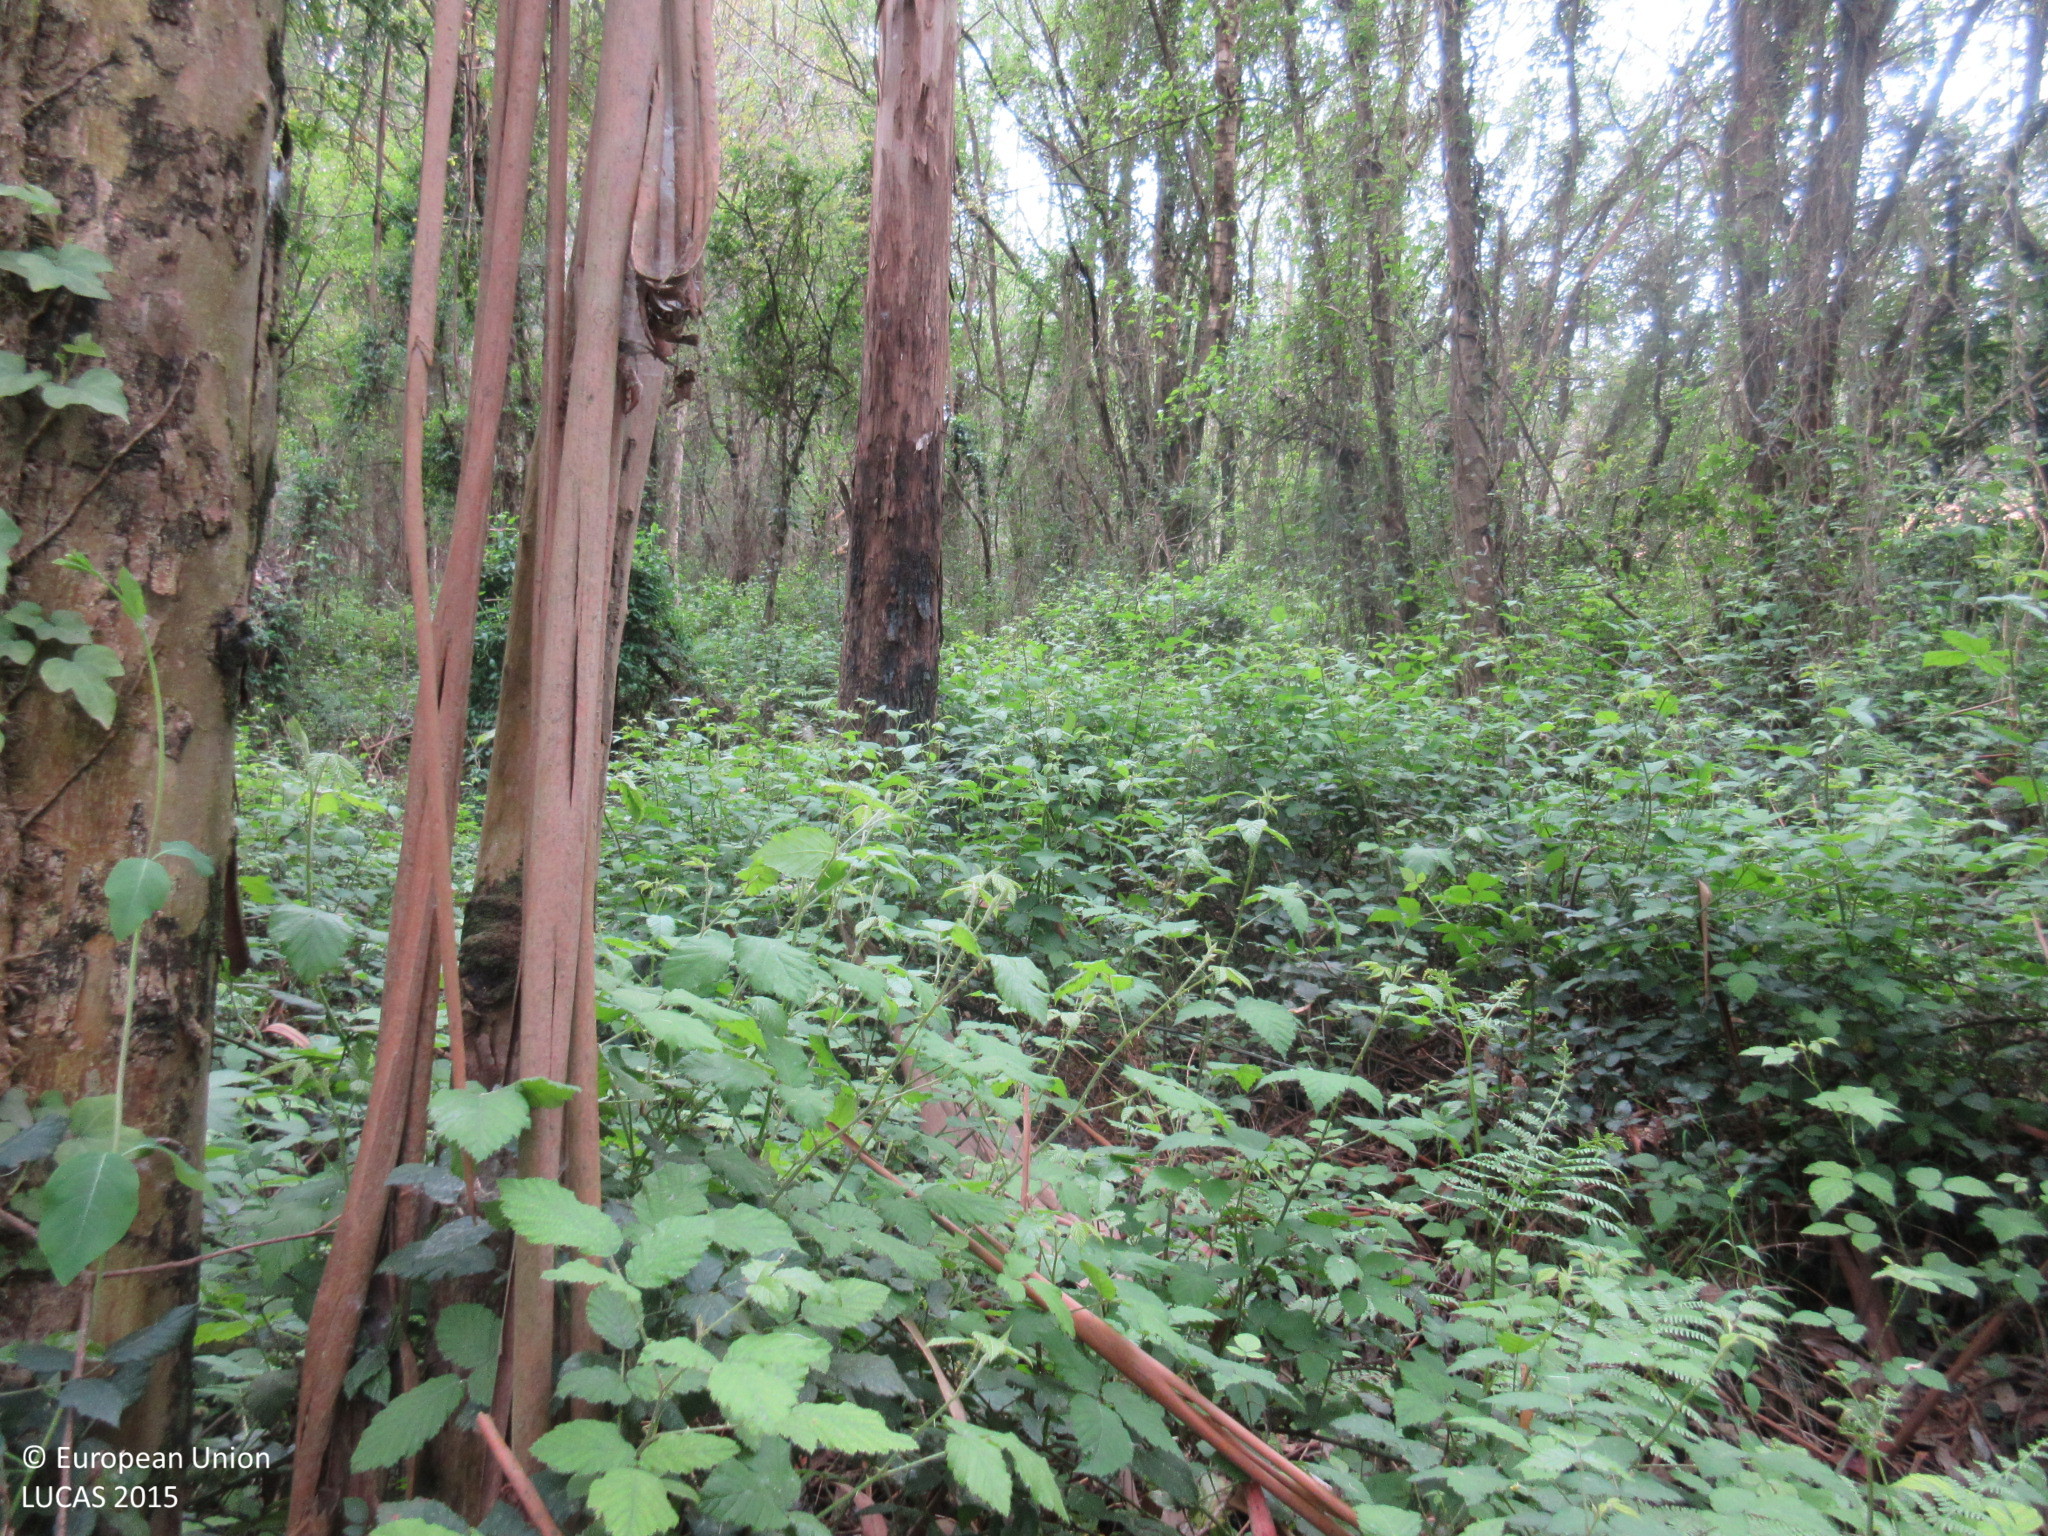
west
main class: Woodland
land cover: Broadleaved woodland
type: exotic forest
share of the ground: > 75 %
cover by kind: broadleaved forest trees 95 %, shrubs 5 %
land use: Forestry
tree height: > 5 m
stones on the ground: < 10 %
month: April
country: ES
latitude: 43.4852
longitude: -7.1216
